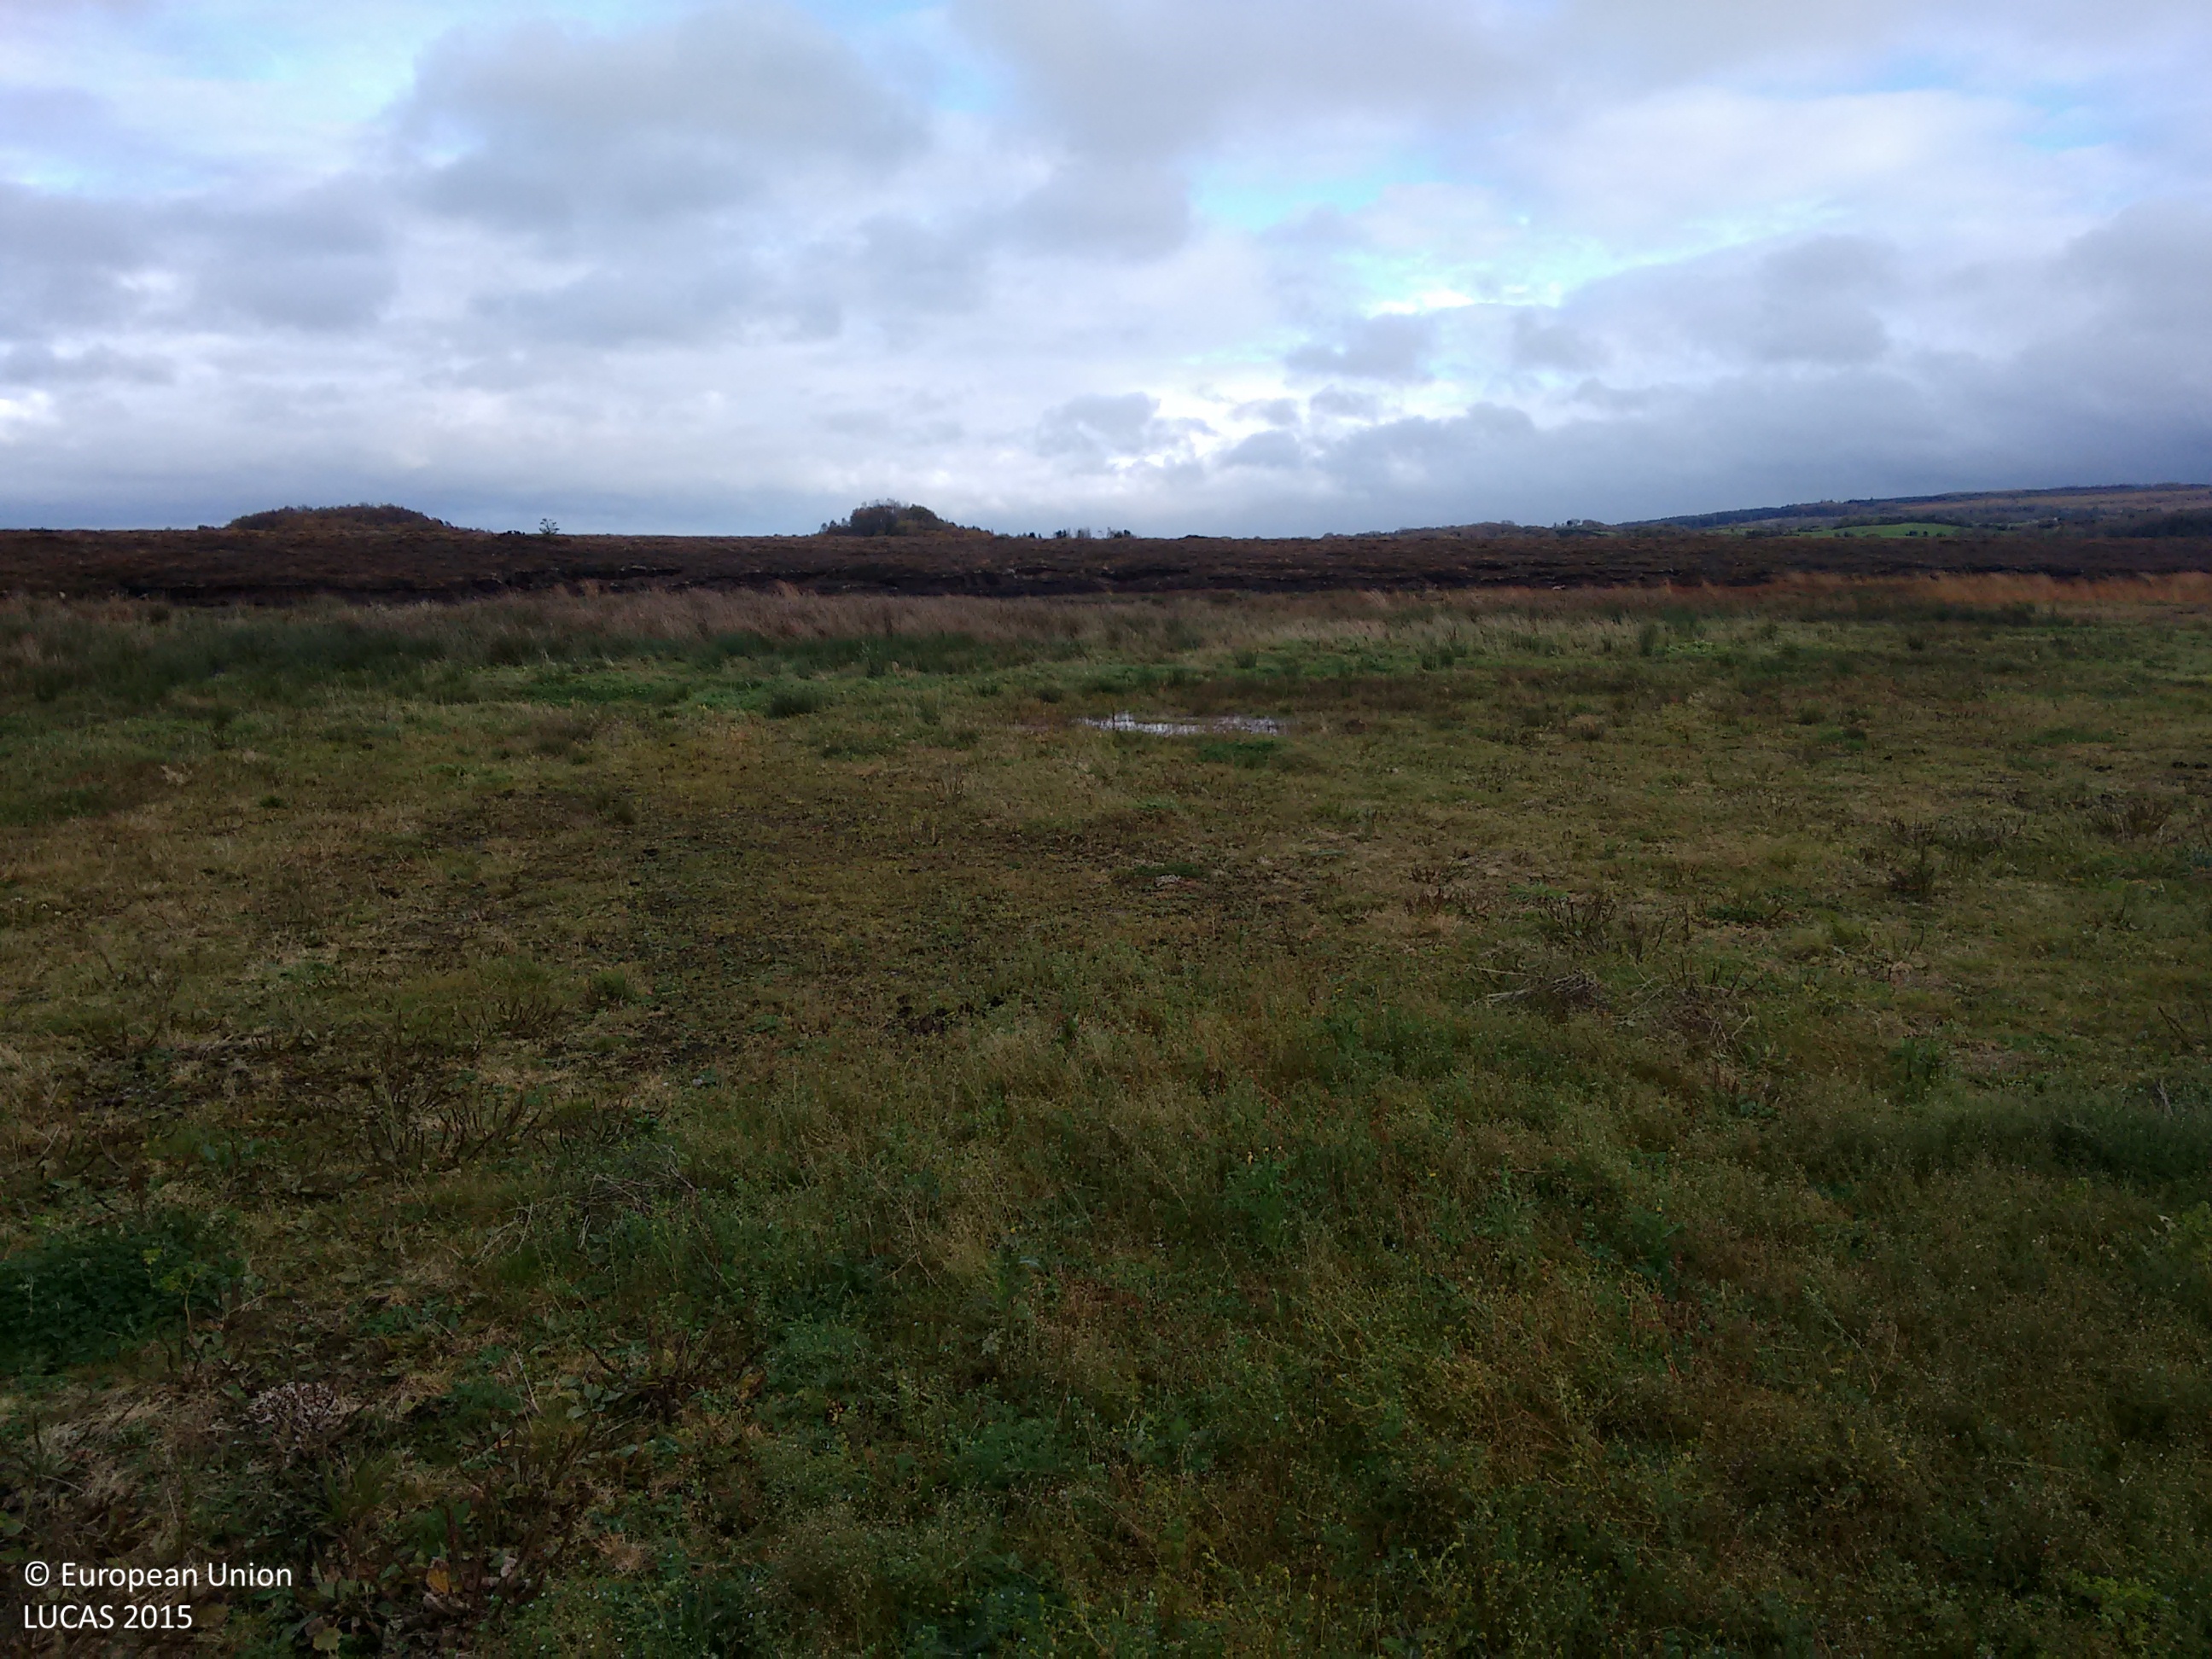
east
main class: Grassland
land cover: Grassland without tree/shrub cover
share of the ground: > 75 %
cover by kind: herbaceous plants 95 %, shrubs 5 %
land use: Agriculture (excluding fallow land and kitchen gardens)
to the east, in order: Grassland without tree/shrub cover; Peatbogs; Ditches and canals; Peatbogs
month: November
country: IE
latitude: 53.1641
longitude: -7.6177
